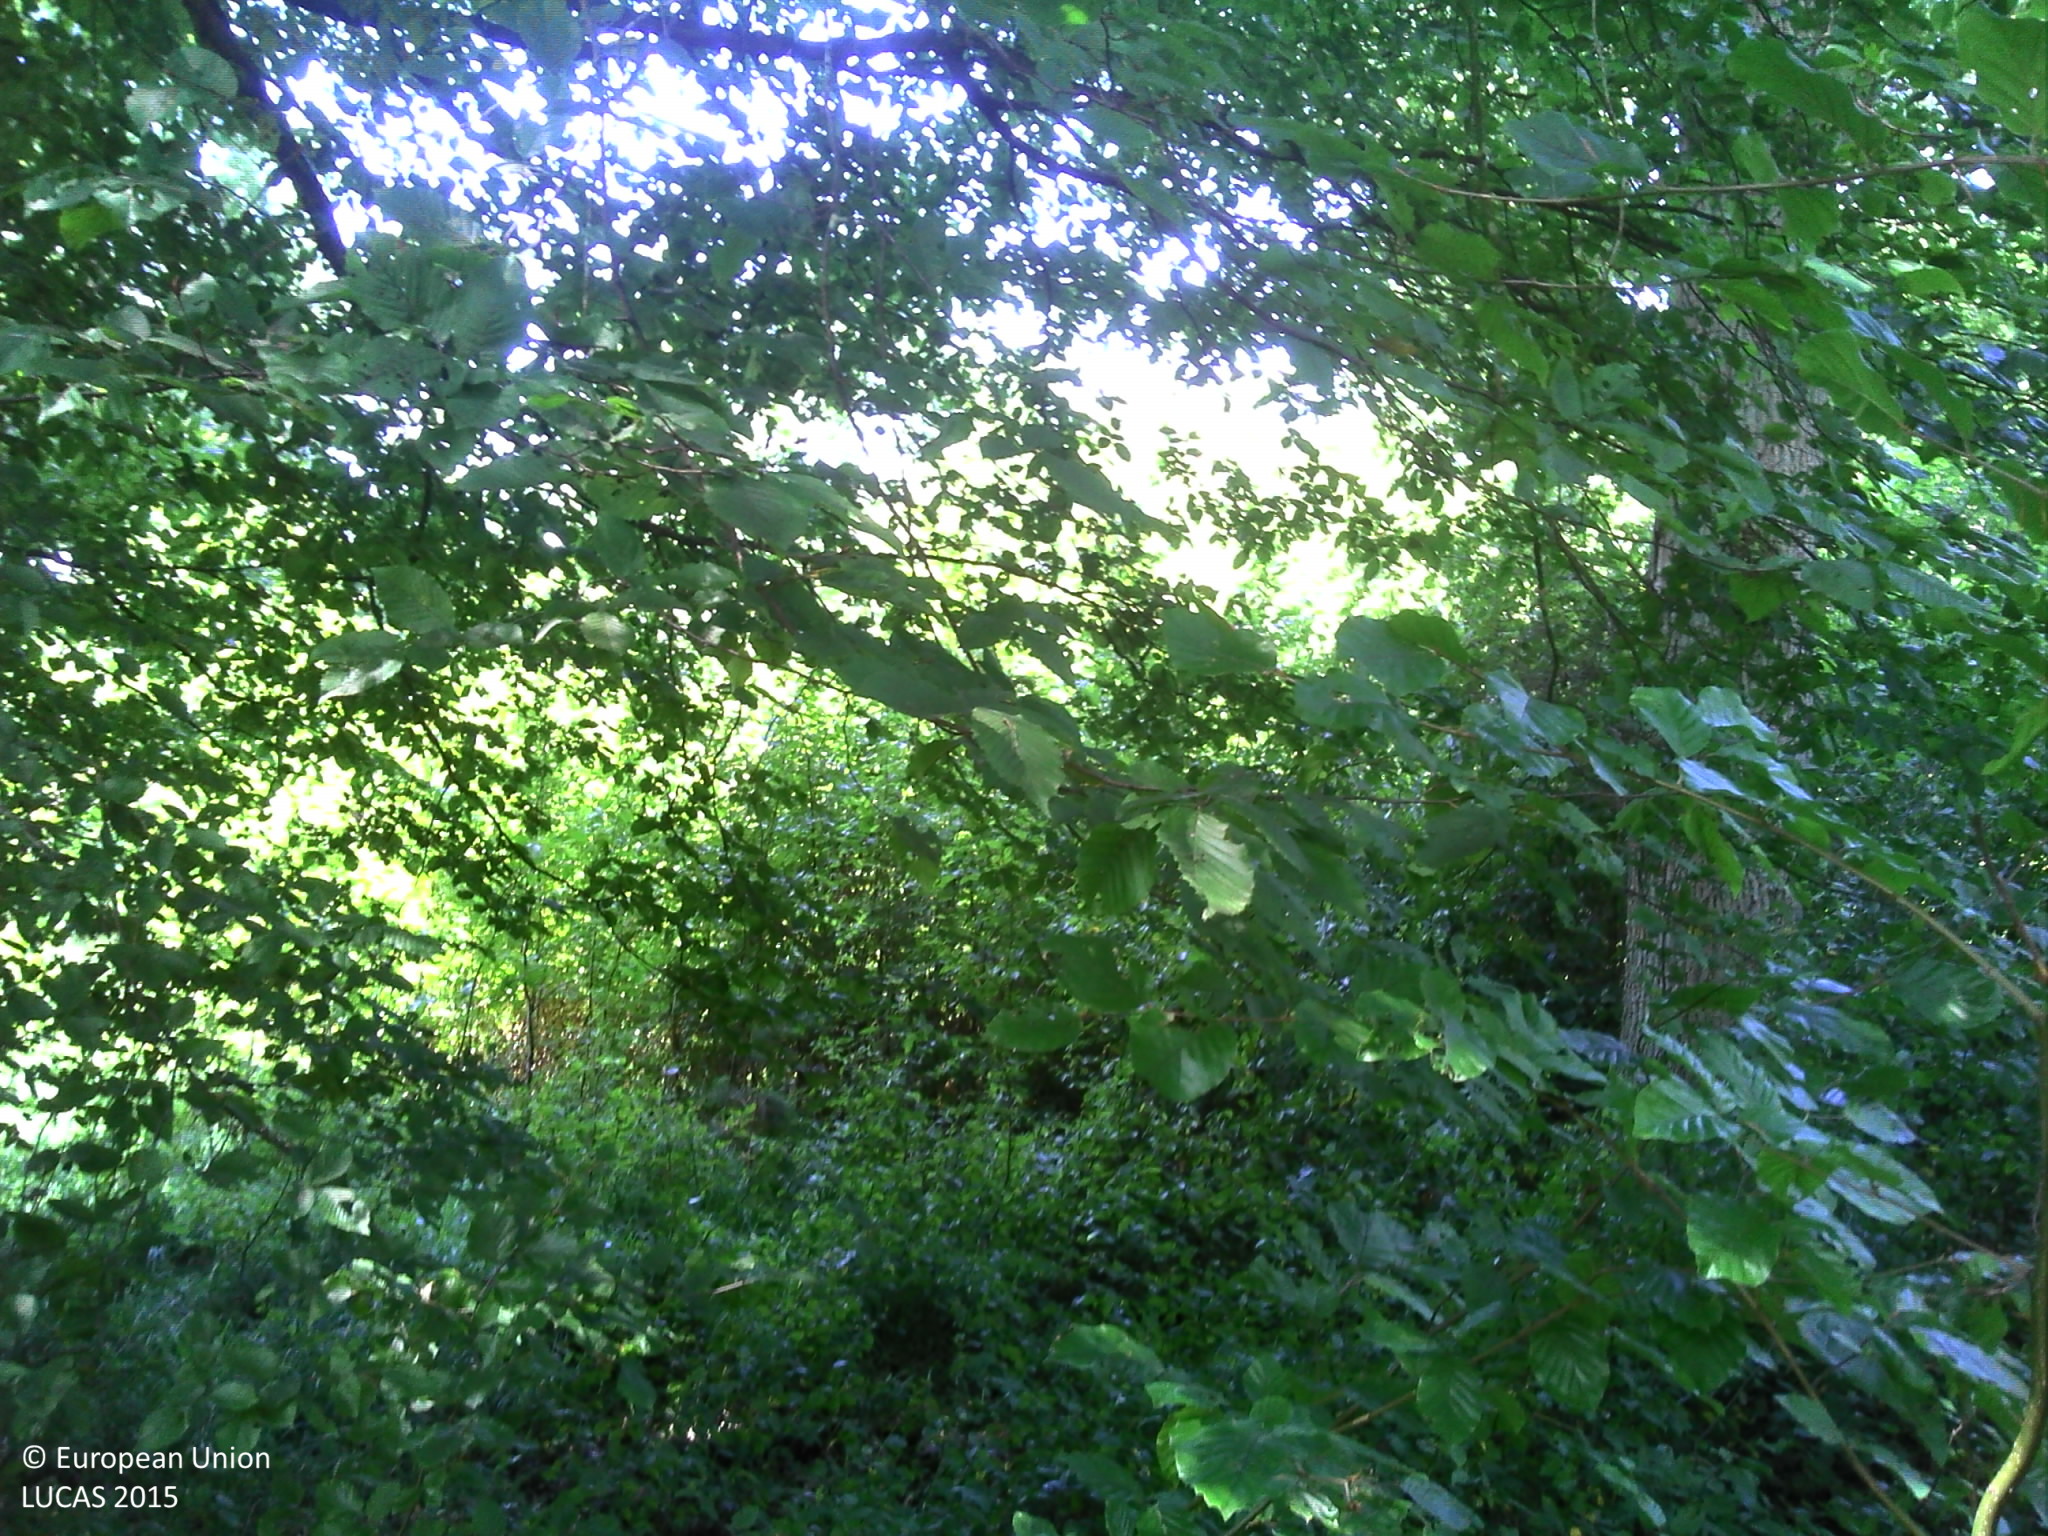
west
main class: Woodland
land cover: Broadleaved woodland
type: mesophytic deciduous forest
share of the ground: > 75 %
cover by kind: broadleaved forest trees 85 %, herbaceous plants 15 %
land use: Forestry
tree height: > 5 m
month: July
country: FR
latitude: 48.8661
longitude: 7.7241
